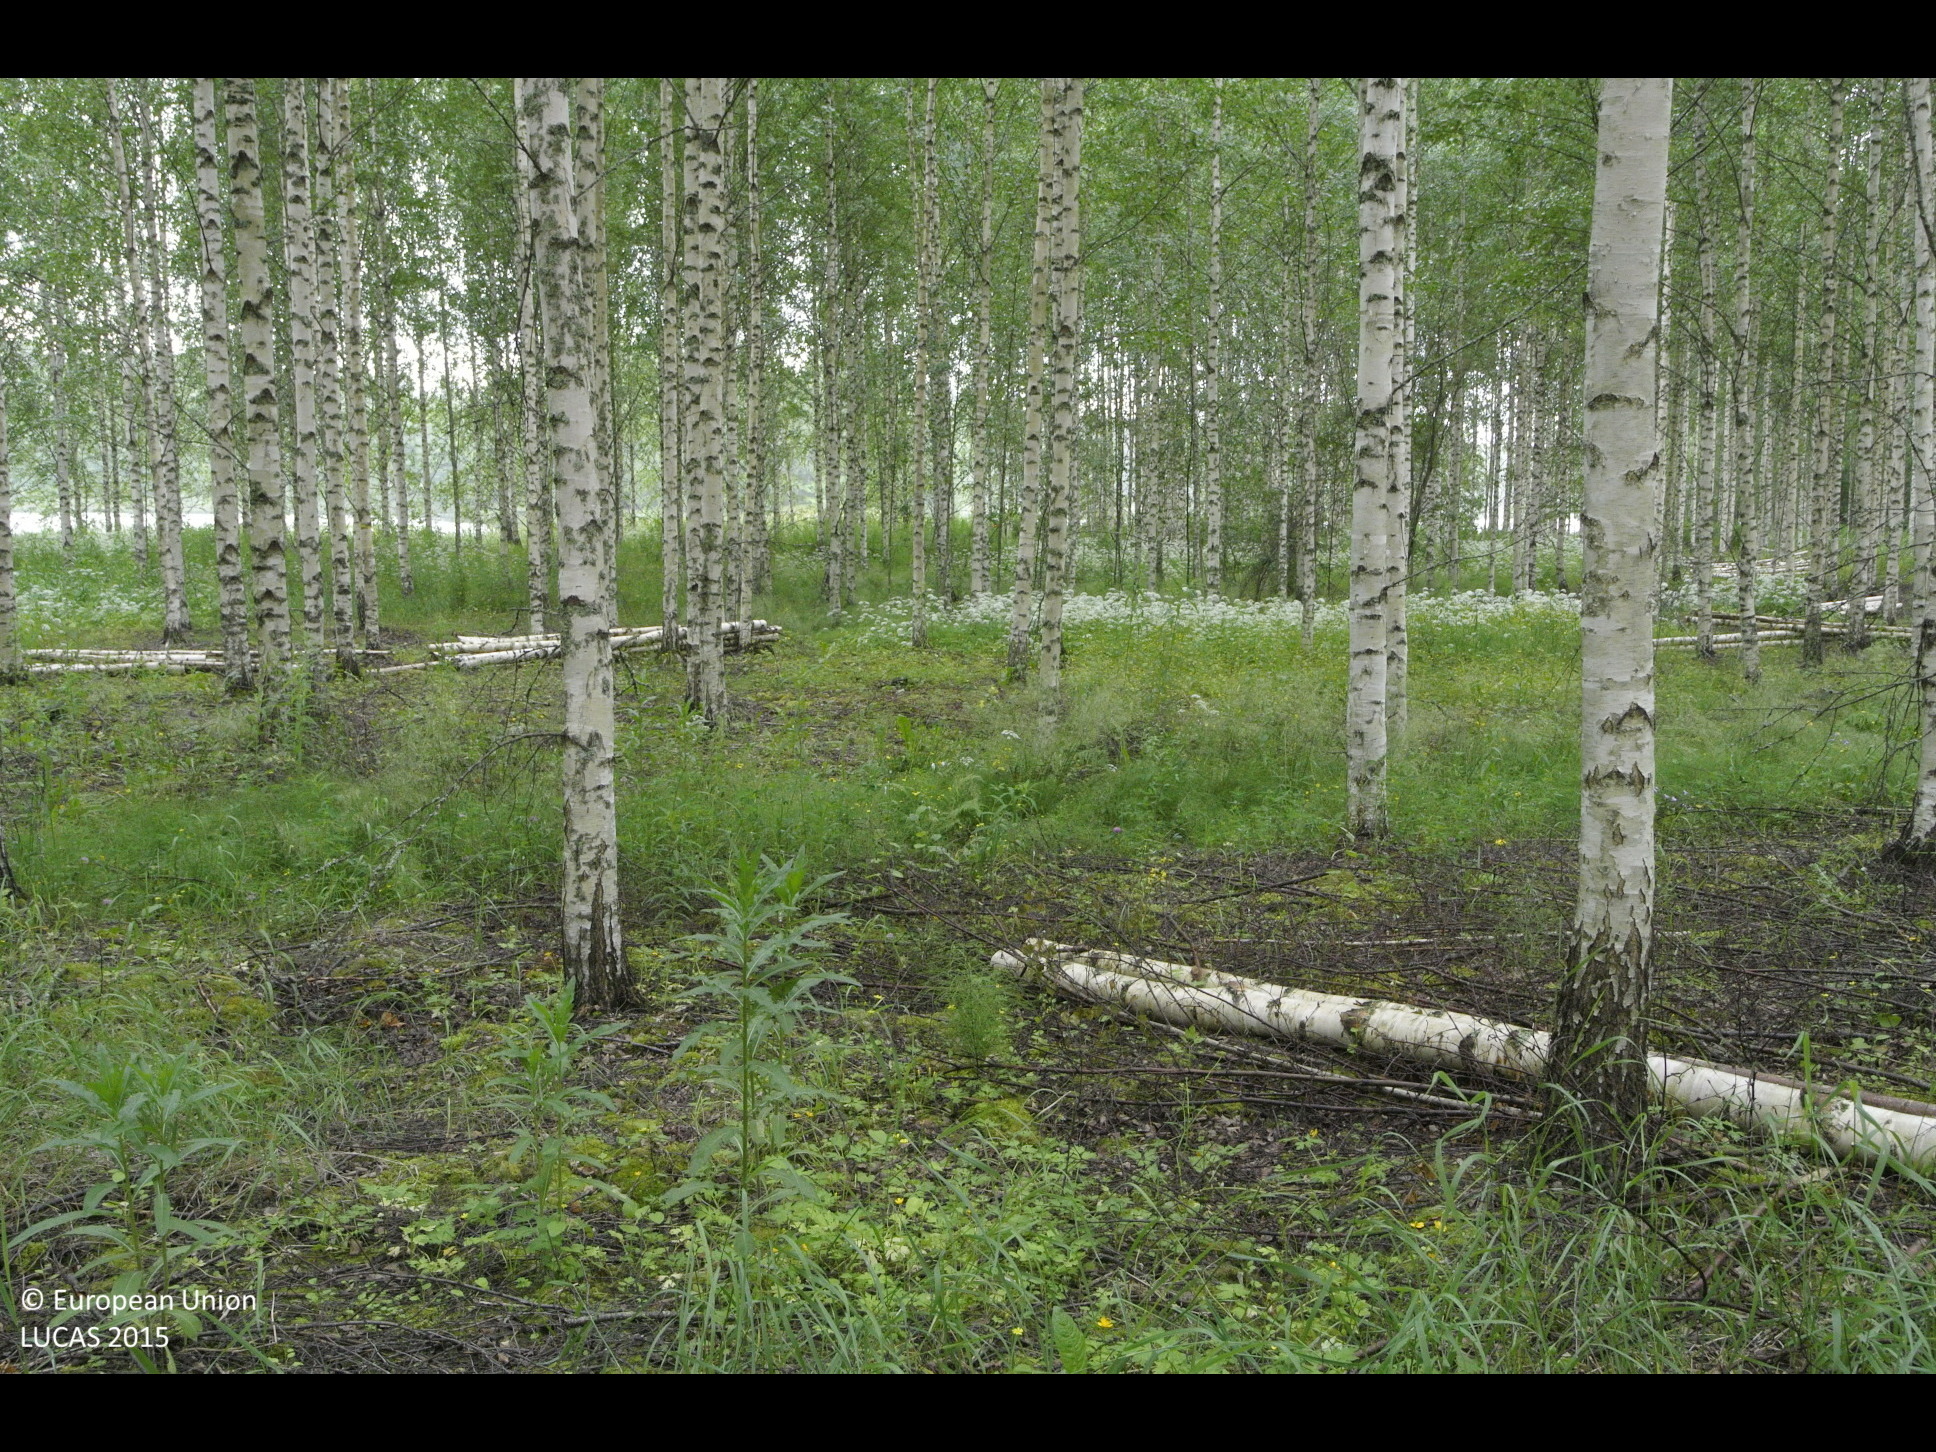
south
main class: Woodland
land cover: Broadleaved woodland
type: non-riverine alder, birch or aspen forest
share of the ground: > 75 %
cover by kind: broadleaved forest trees 85 %, herbaceous plants 15 %
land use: Forestry
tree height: > 5 m
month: July
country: FI
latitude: 61.5483
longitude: 25.8019
